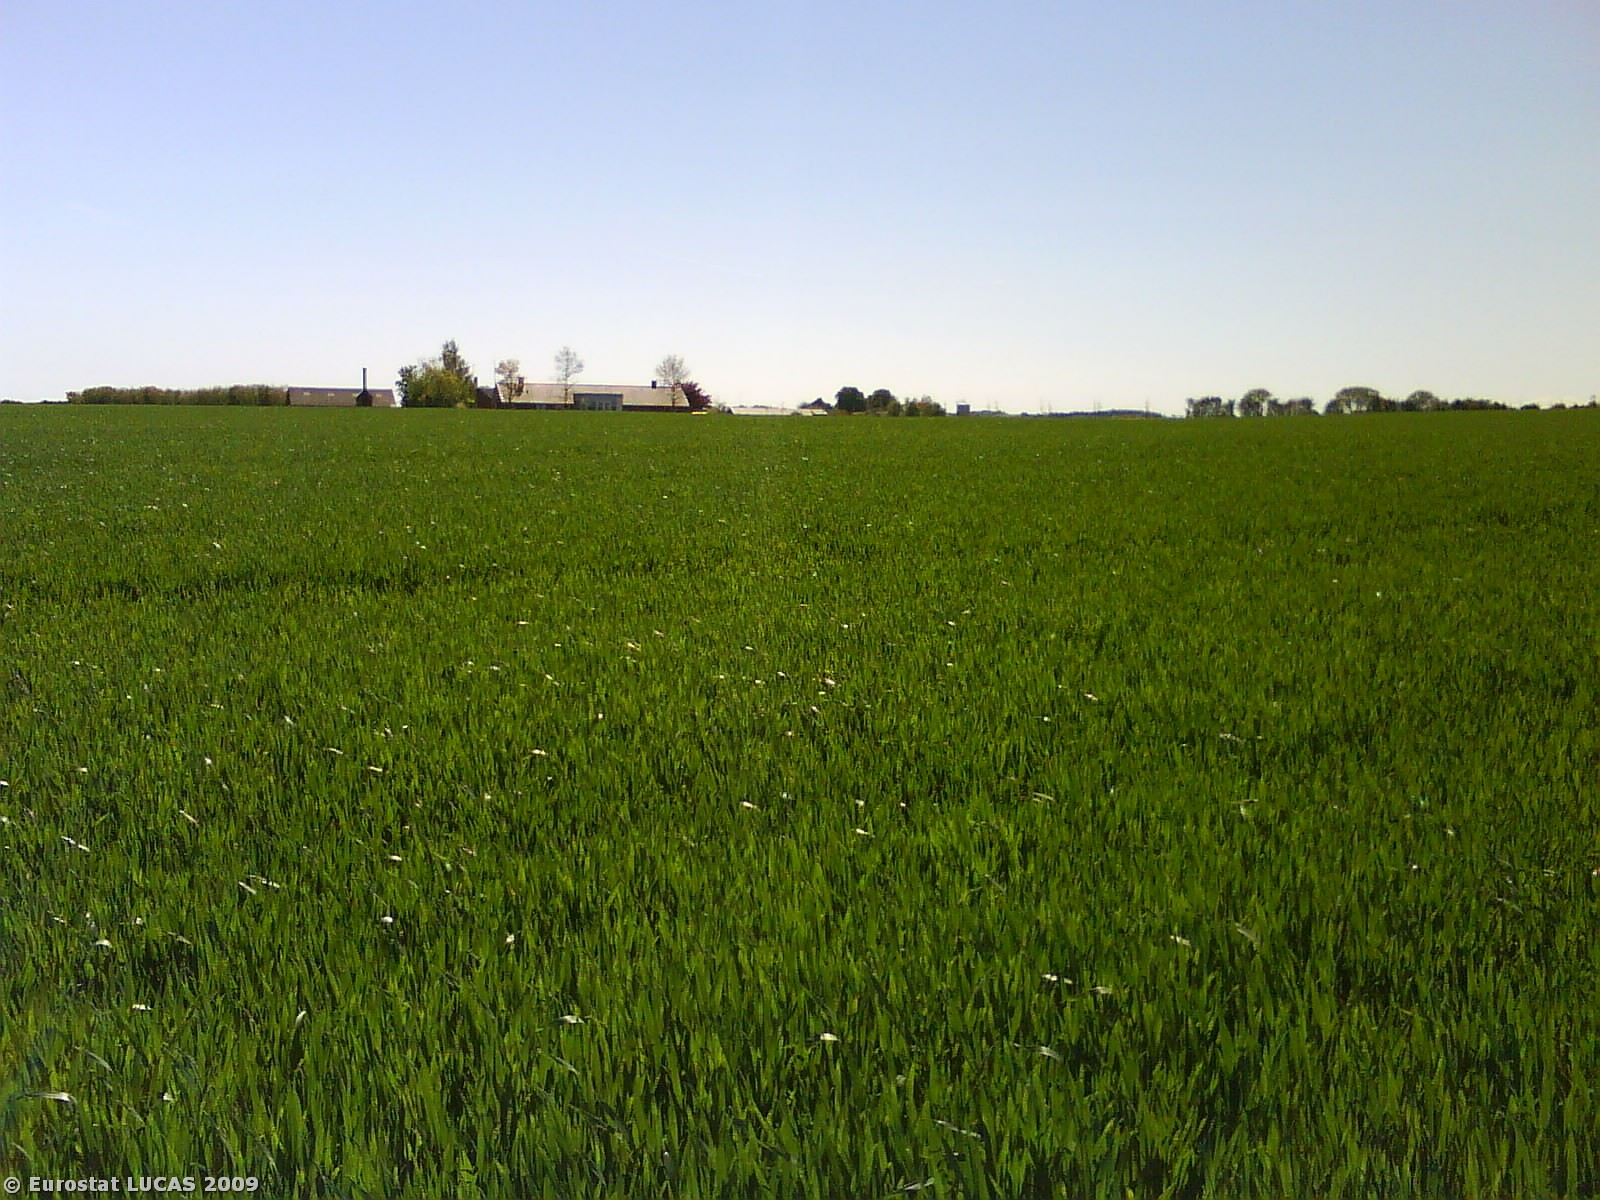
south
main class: Cropland
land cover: Common wheat
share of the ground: > 75 %
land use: Agriculture (excluding fallow land and kitchen gardens)
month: May
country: DK
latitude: 56.4723
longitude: 10.8917
